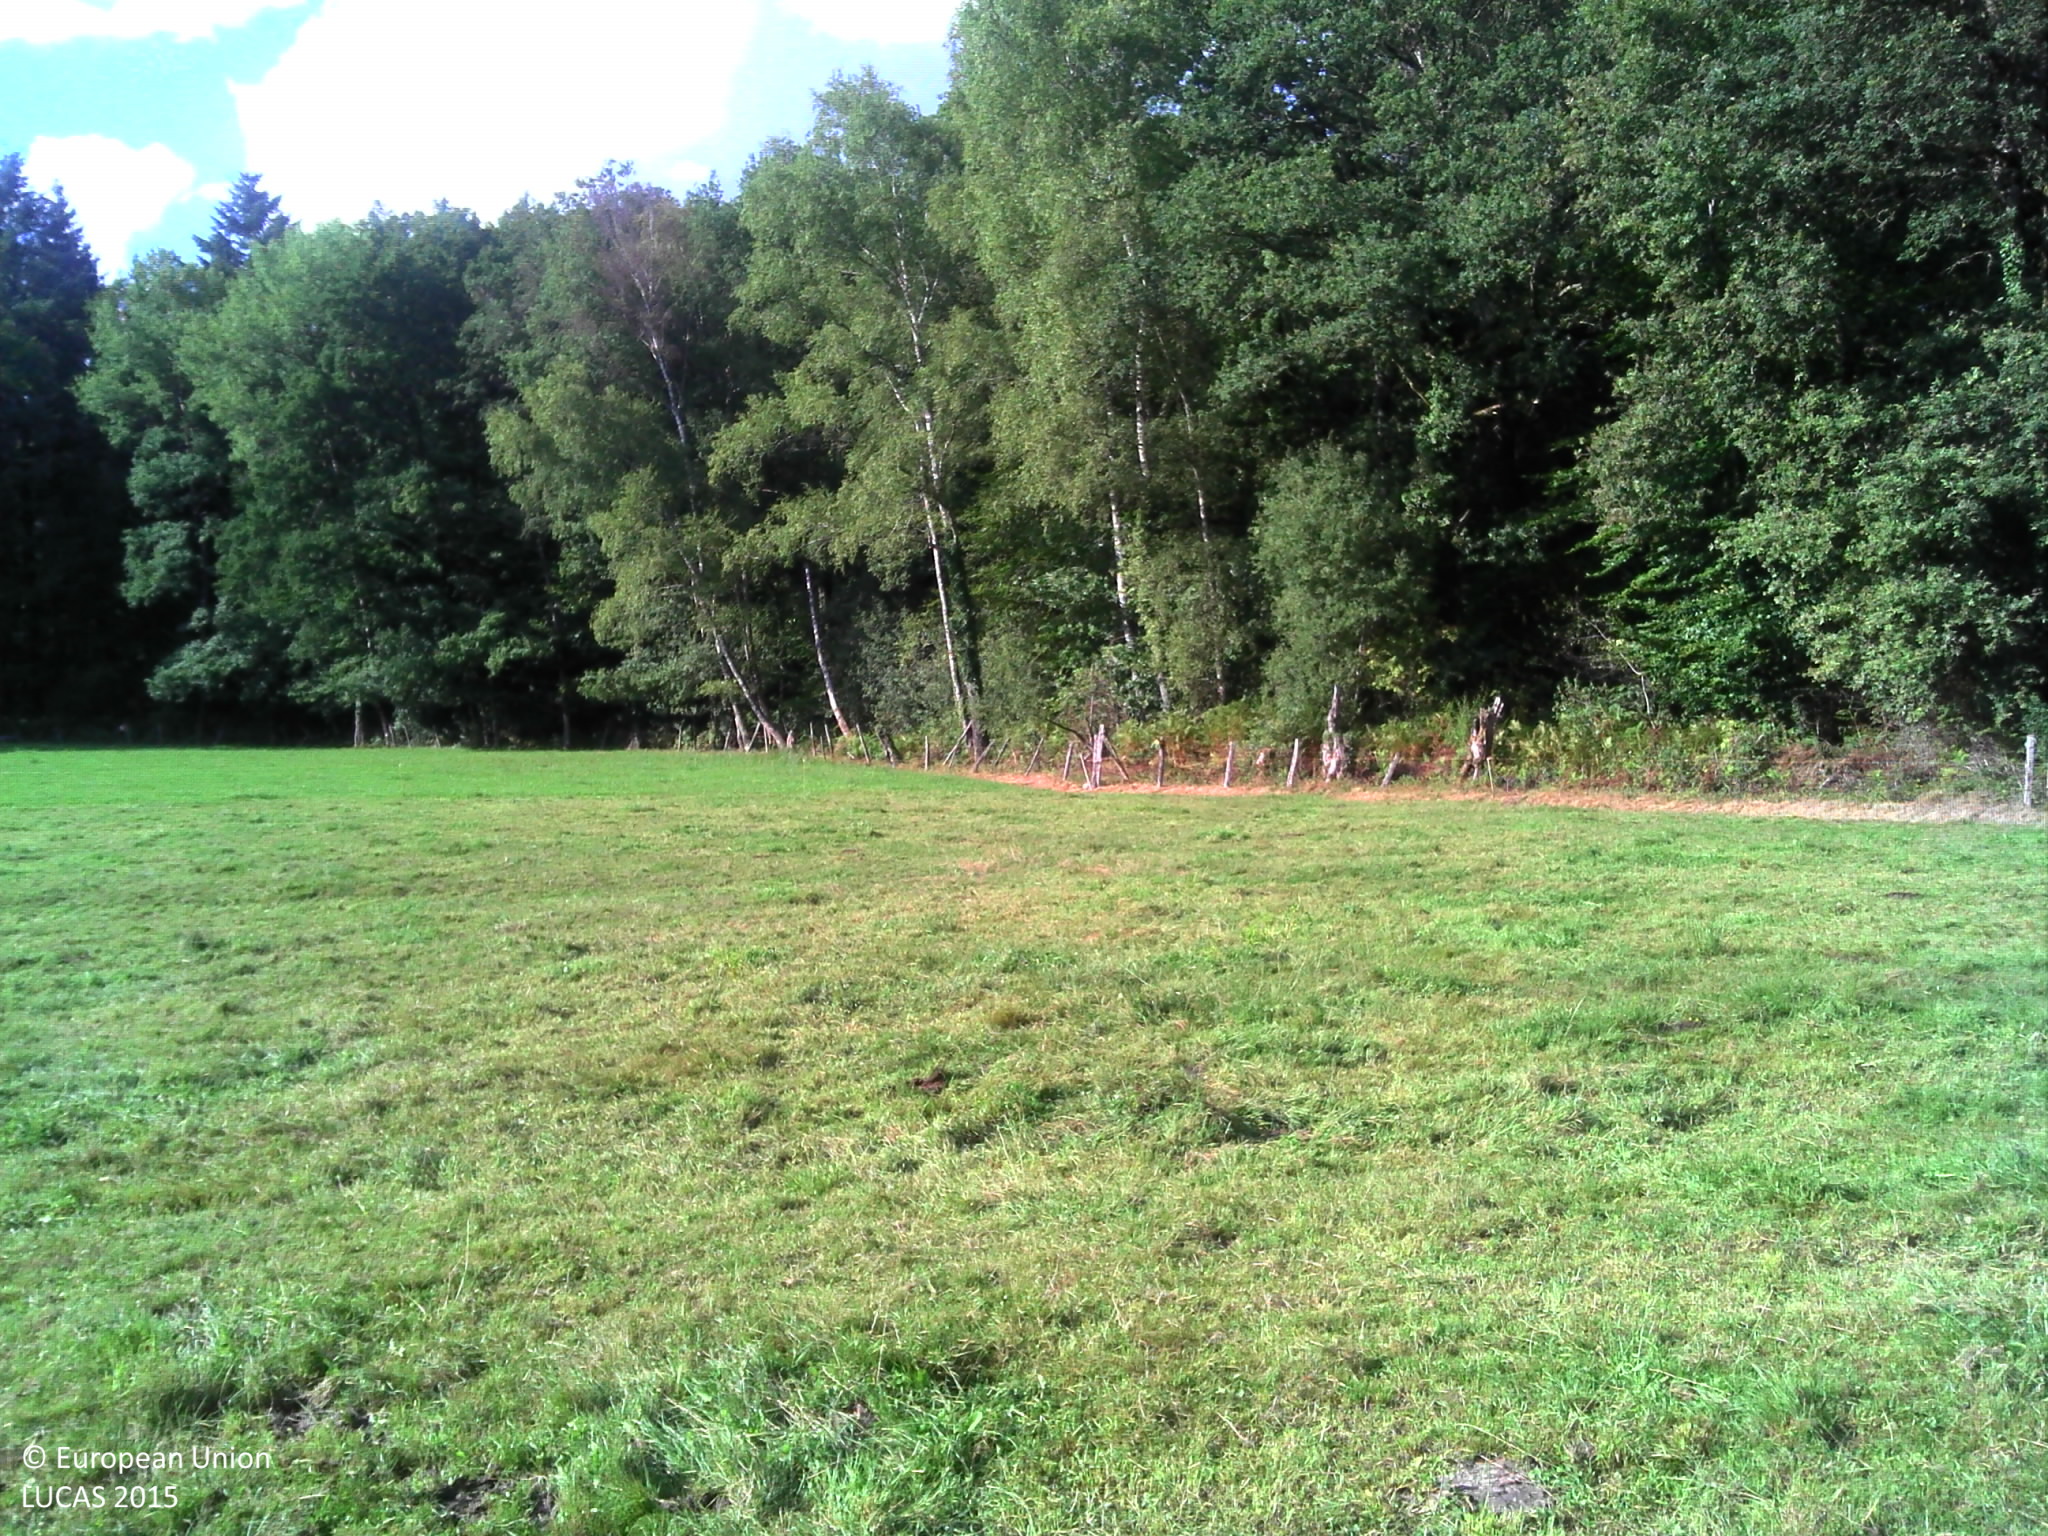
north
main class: Grassland
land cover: Grassland without tree/shrub cover
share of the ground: > 75 %
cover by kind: herbaceous plants 100 %
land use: Agriculture (excluding fallow land and kitchen gardens)
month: August
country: FR
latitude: 45.9238
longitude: 1.7536
